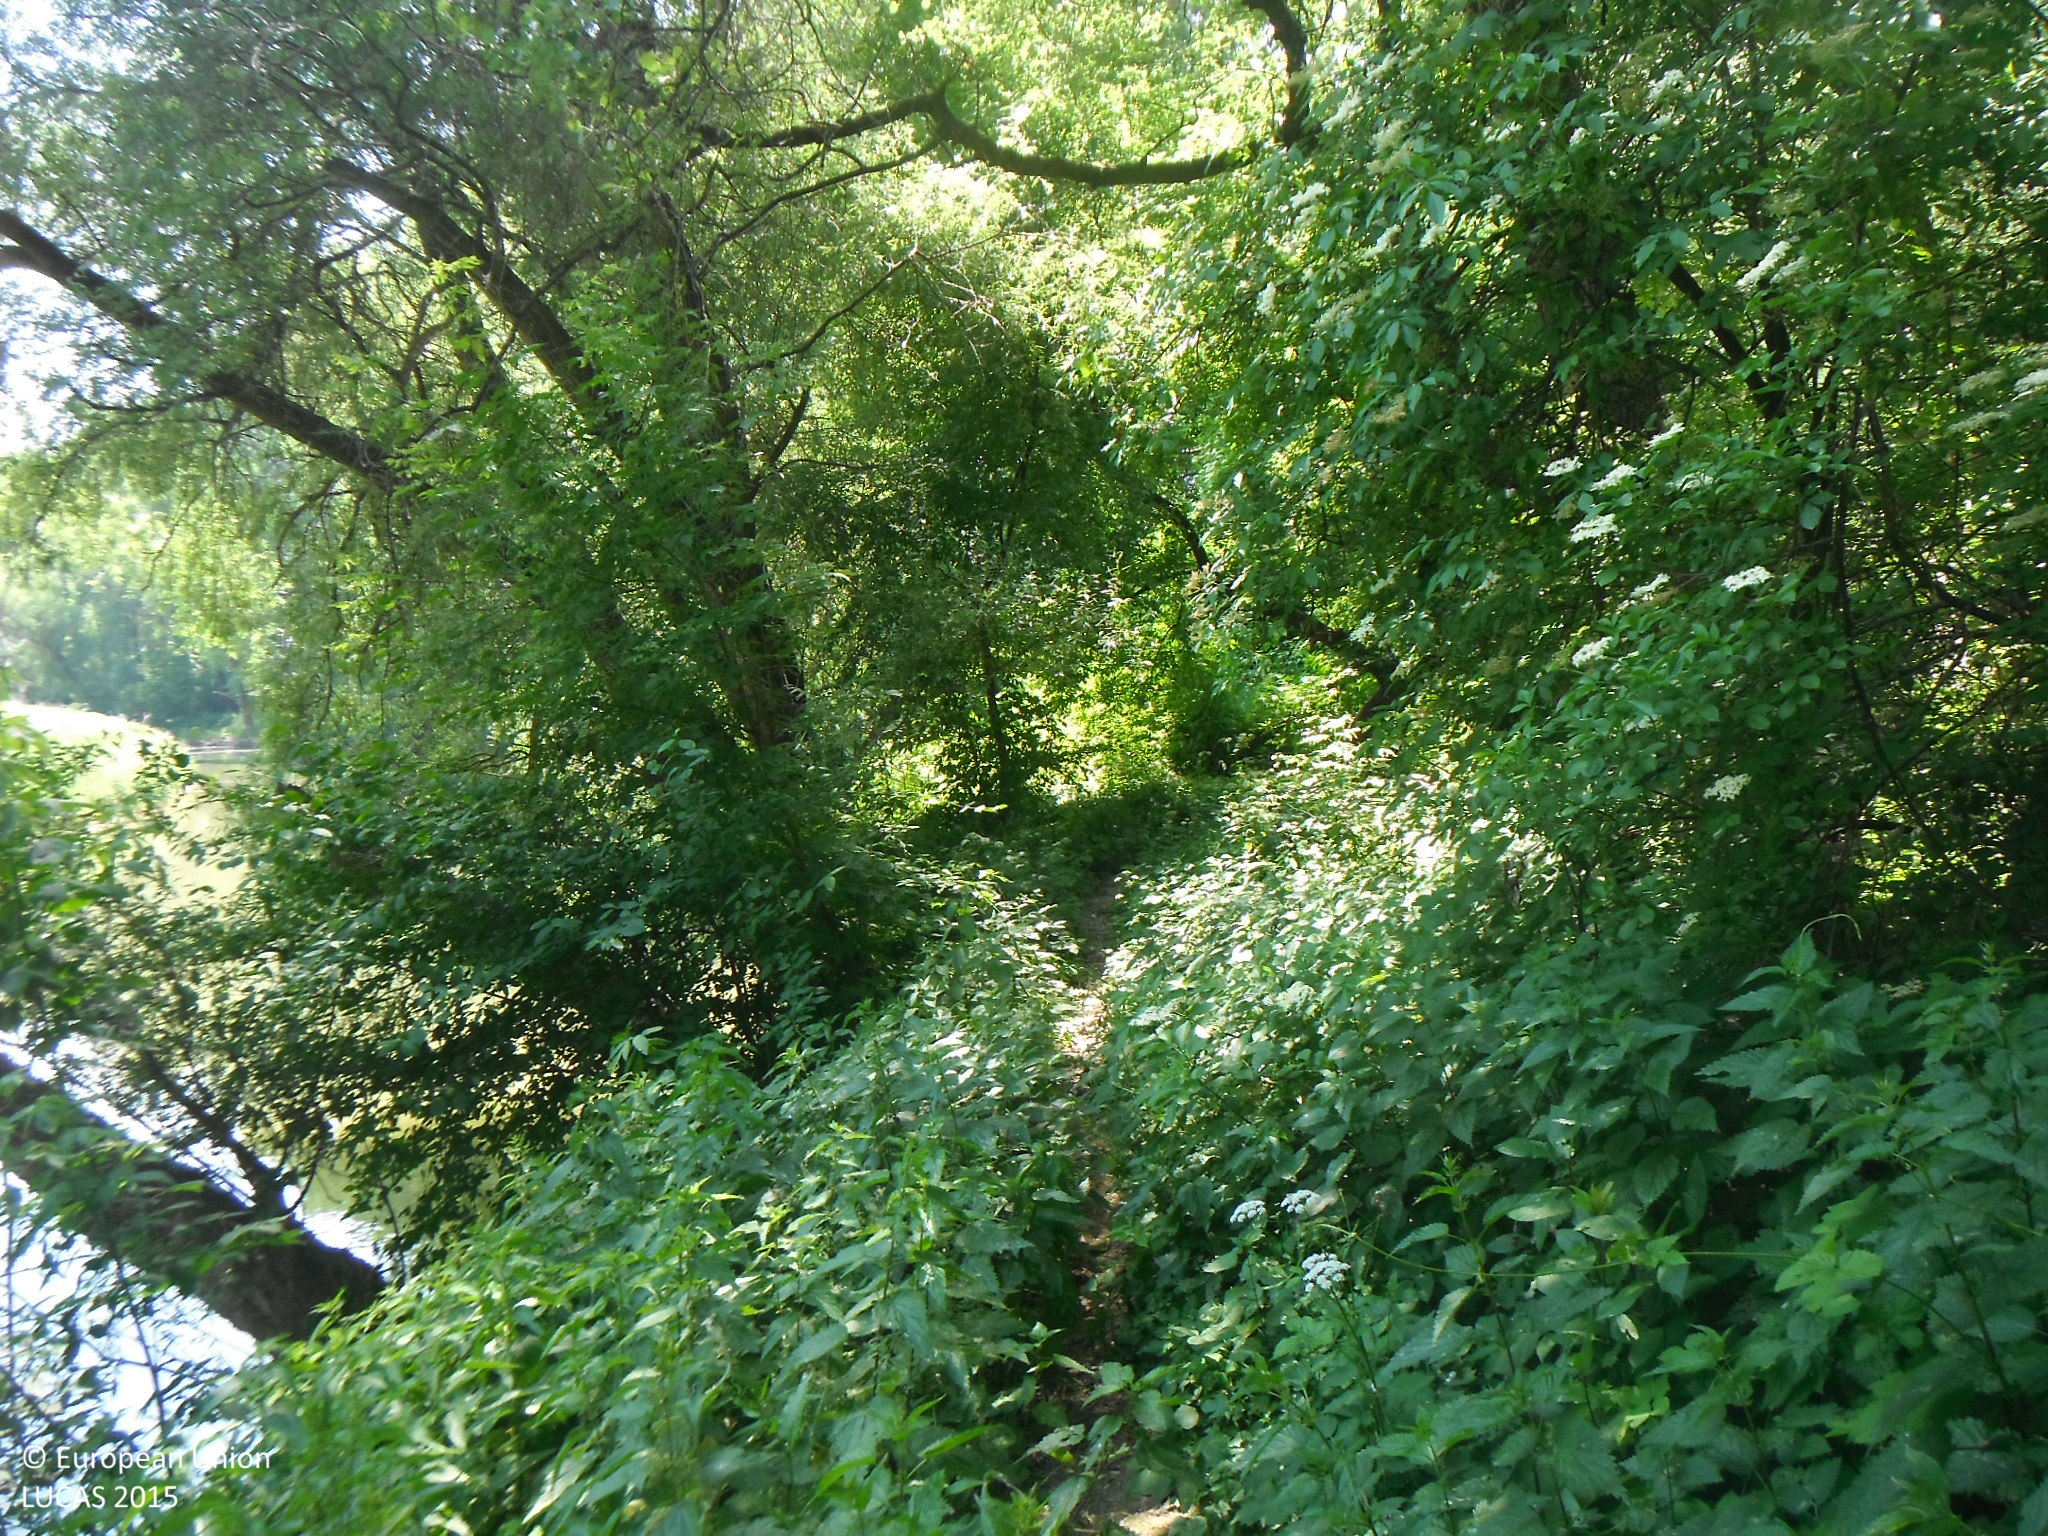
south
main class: Grassland
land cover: Spontaneously vegetated surfaces
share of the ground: > 75 %
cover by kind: herbaceous plants 95 %, shrubs 5 %
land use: Semi-natural and natural areas not in use
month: June
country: SK
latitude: 48.7966
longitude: 21.8833
